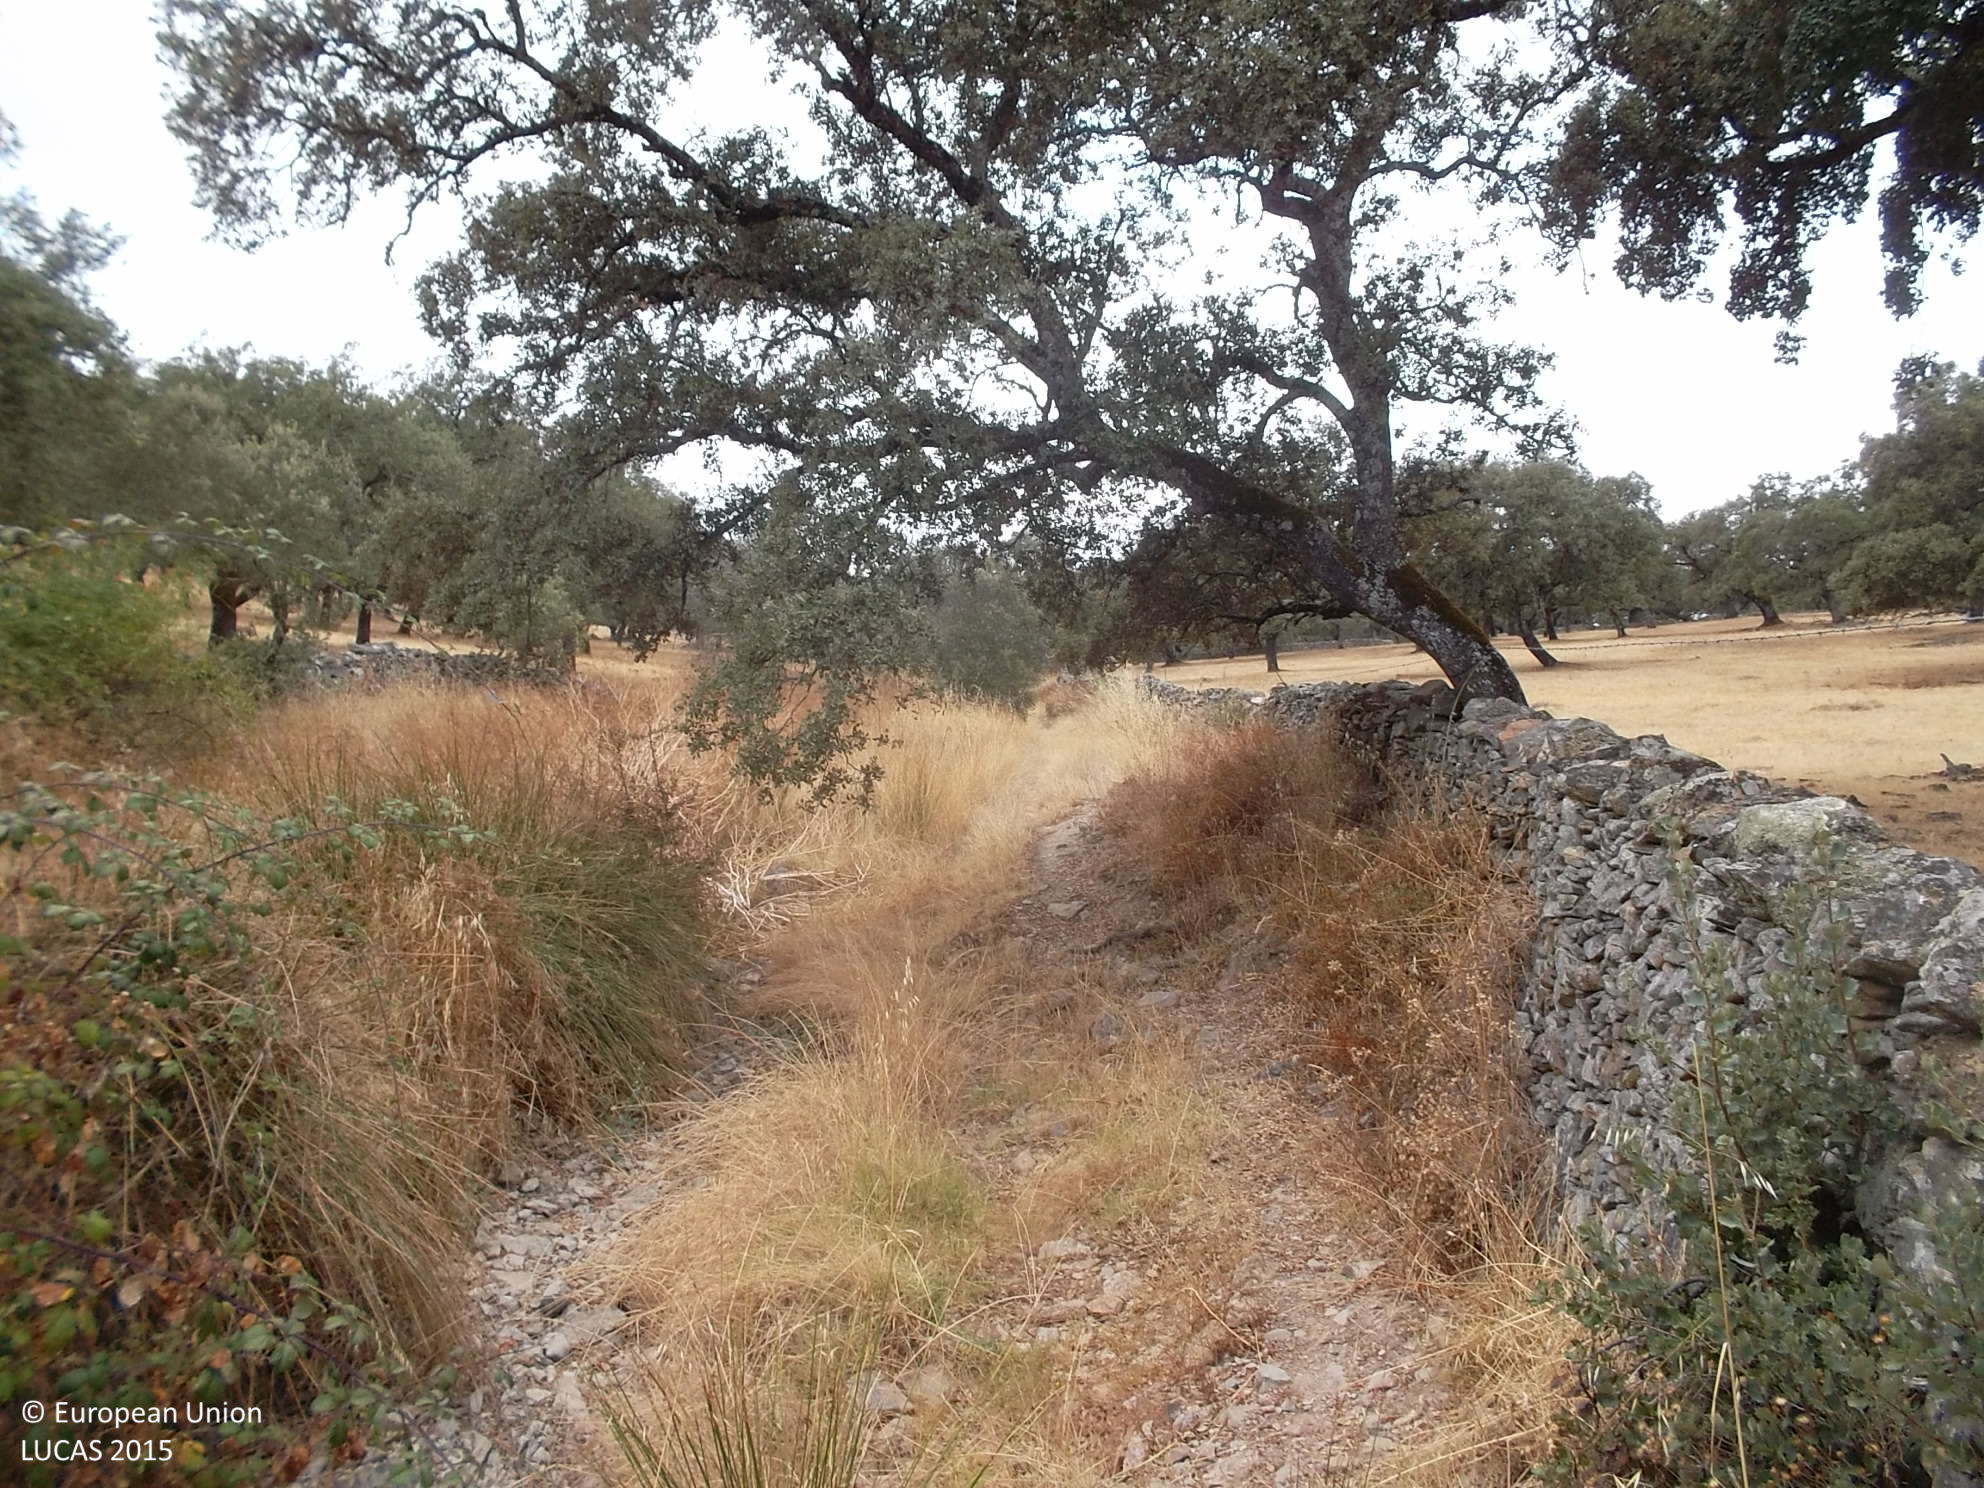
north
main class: Woodland
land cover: Broadleaved woodland
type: broadleaved evergreen forest
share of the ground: 50 - 75 %
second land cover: Grassland without tree/shrub cover
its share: > 75 %
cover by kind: broadleaved forest trees 50 %, herbaceous plants 50 %
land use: Forestry
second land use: Agriculture (excluding fallow land and kitchen gardens)
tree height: > 5 m
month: September
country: ES
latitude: 38.0877
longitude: -6.5912
